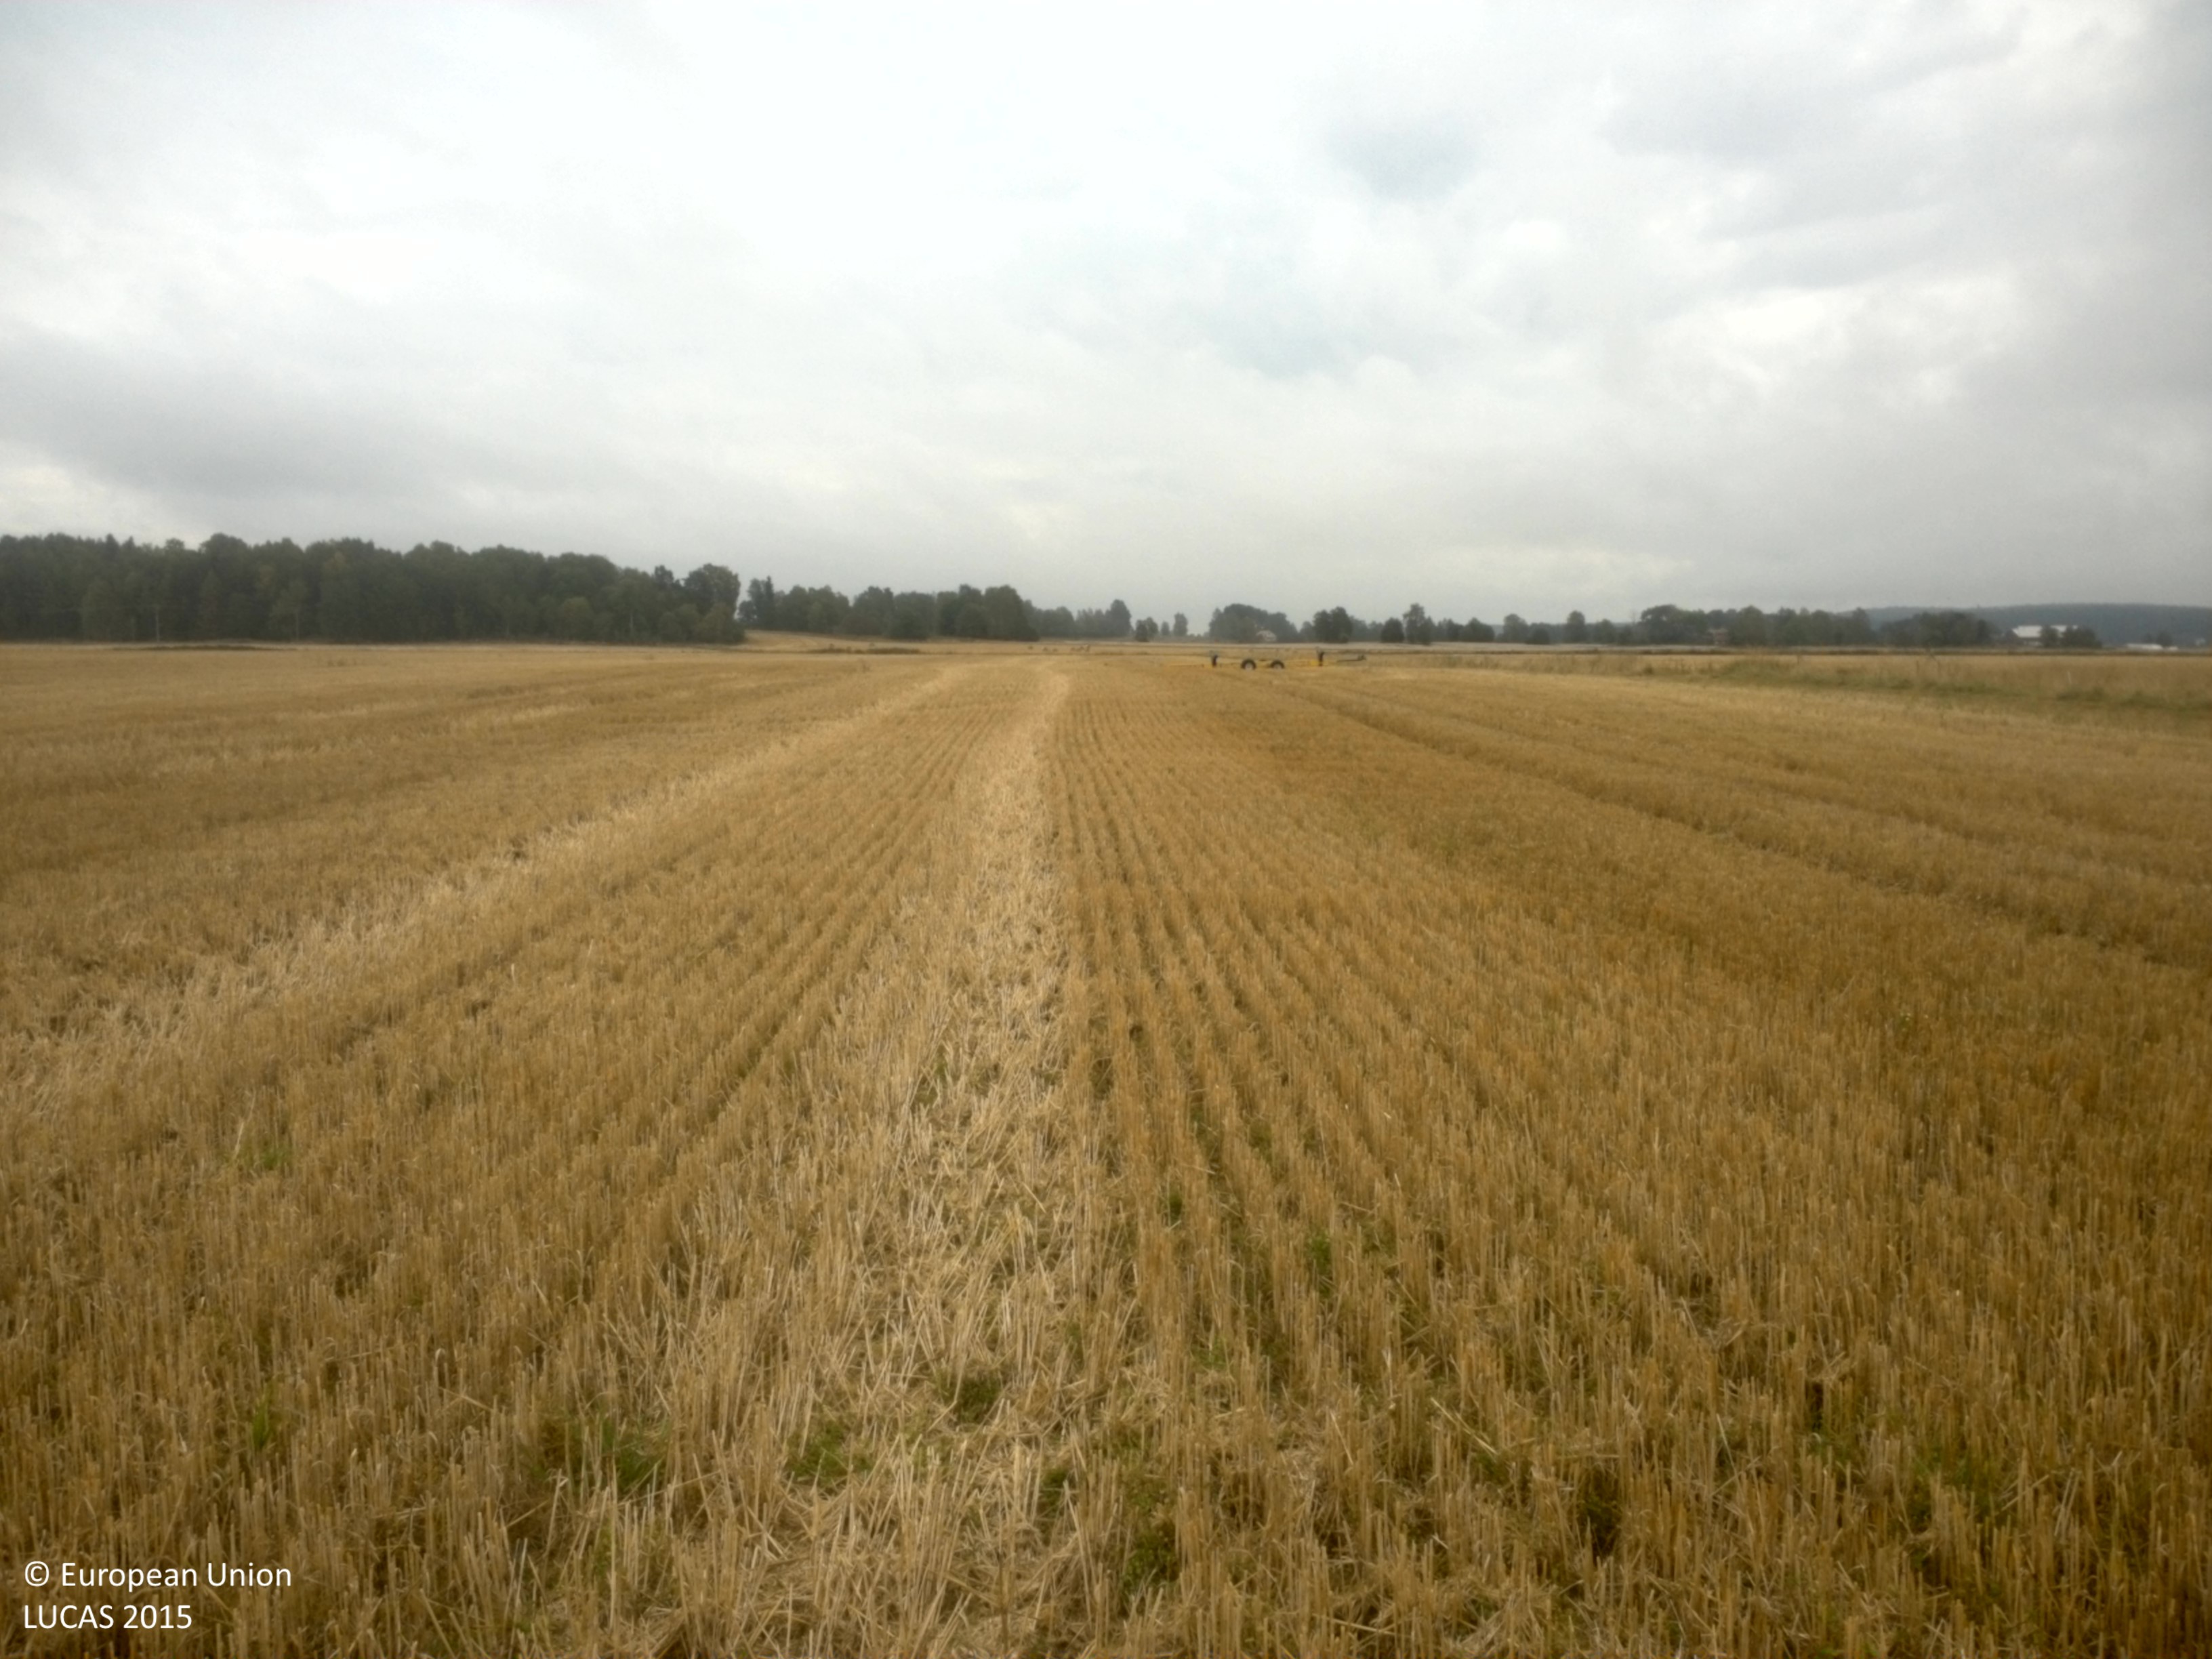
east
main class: Cropland
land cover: Common wheat
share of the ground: > 75 %
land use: Agriculture (excluding fallow land and kitchen gardens)
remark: Harvested field
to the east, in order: Common wheat
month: September
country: SE
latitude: 59.4193
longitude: 15.6129
